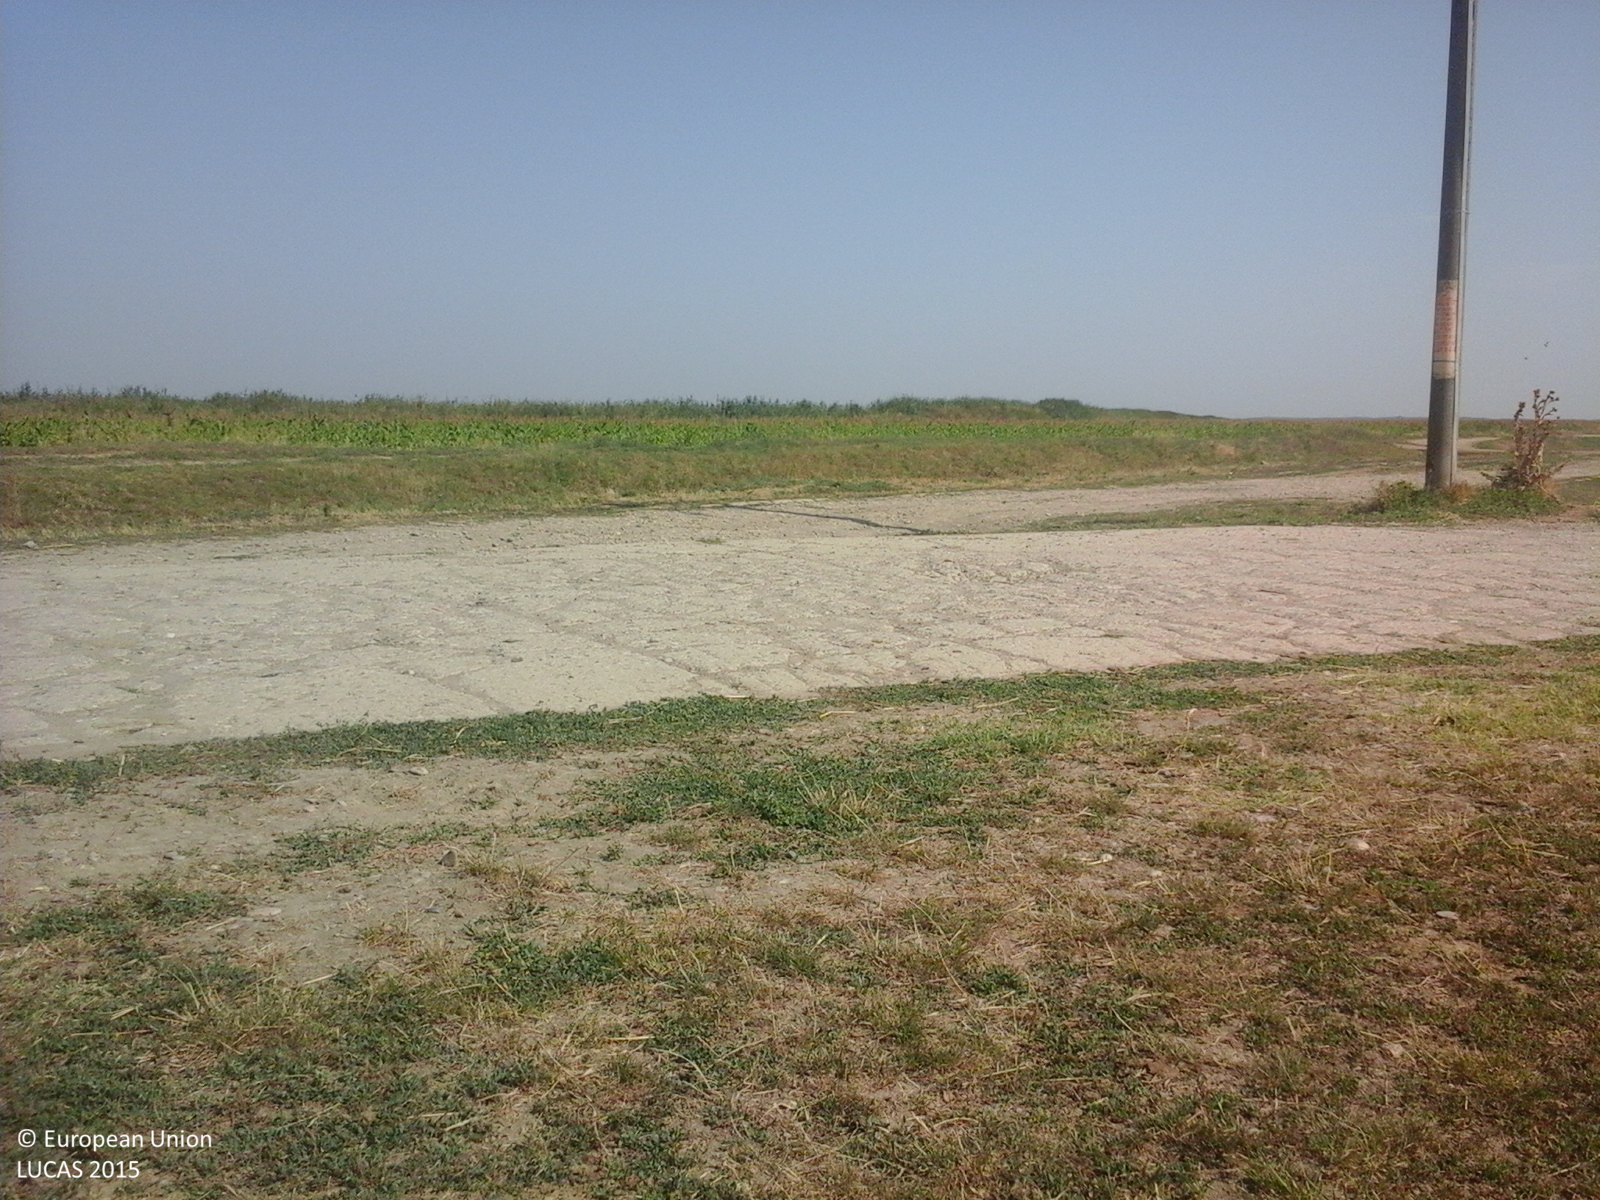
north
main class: Grassland
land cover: Grassland without tree/shrub cover
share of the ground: > 75 %
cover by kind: herbaceous plants 100 %
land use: Agriculture (excluding fallow land and kitchen gardens)
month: August
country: RO
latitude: 45.3644
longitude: 27.7659
